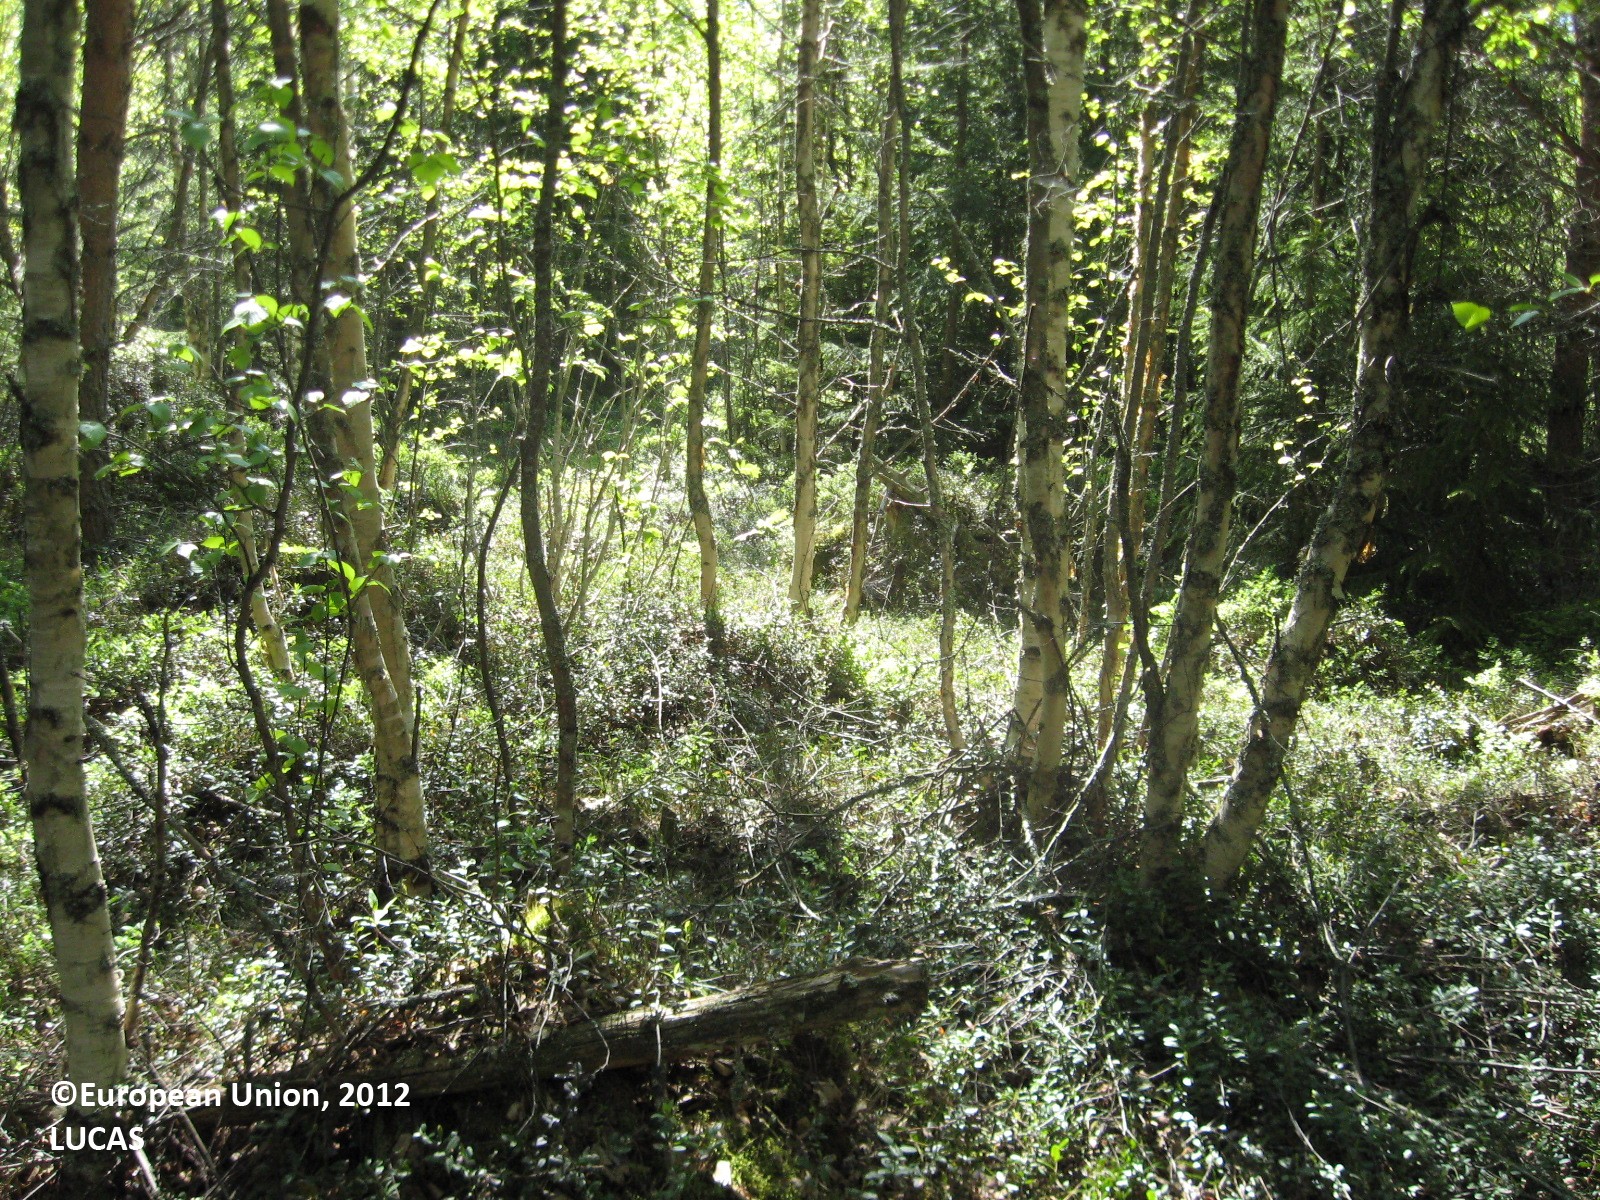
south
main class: Woodland
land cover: Pine dominated mixed woodland
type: boreal forest
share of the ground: > 75 %
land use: Forestry
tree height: > 5 m
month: June
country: FI
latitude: 63.2042
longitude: 21.3496
